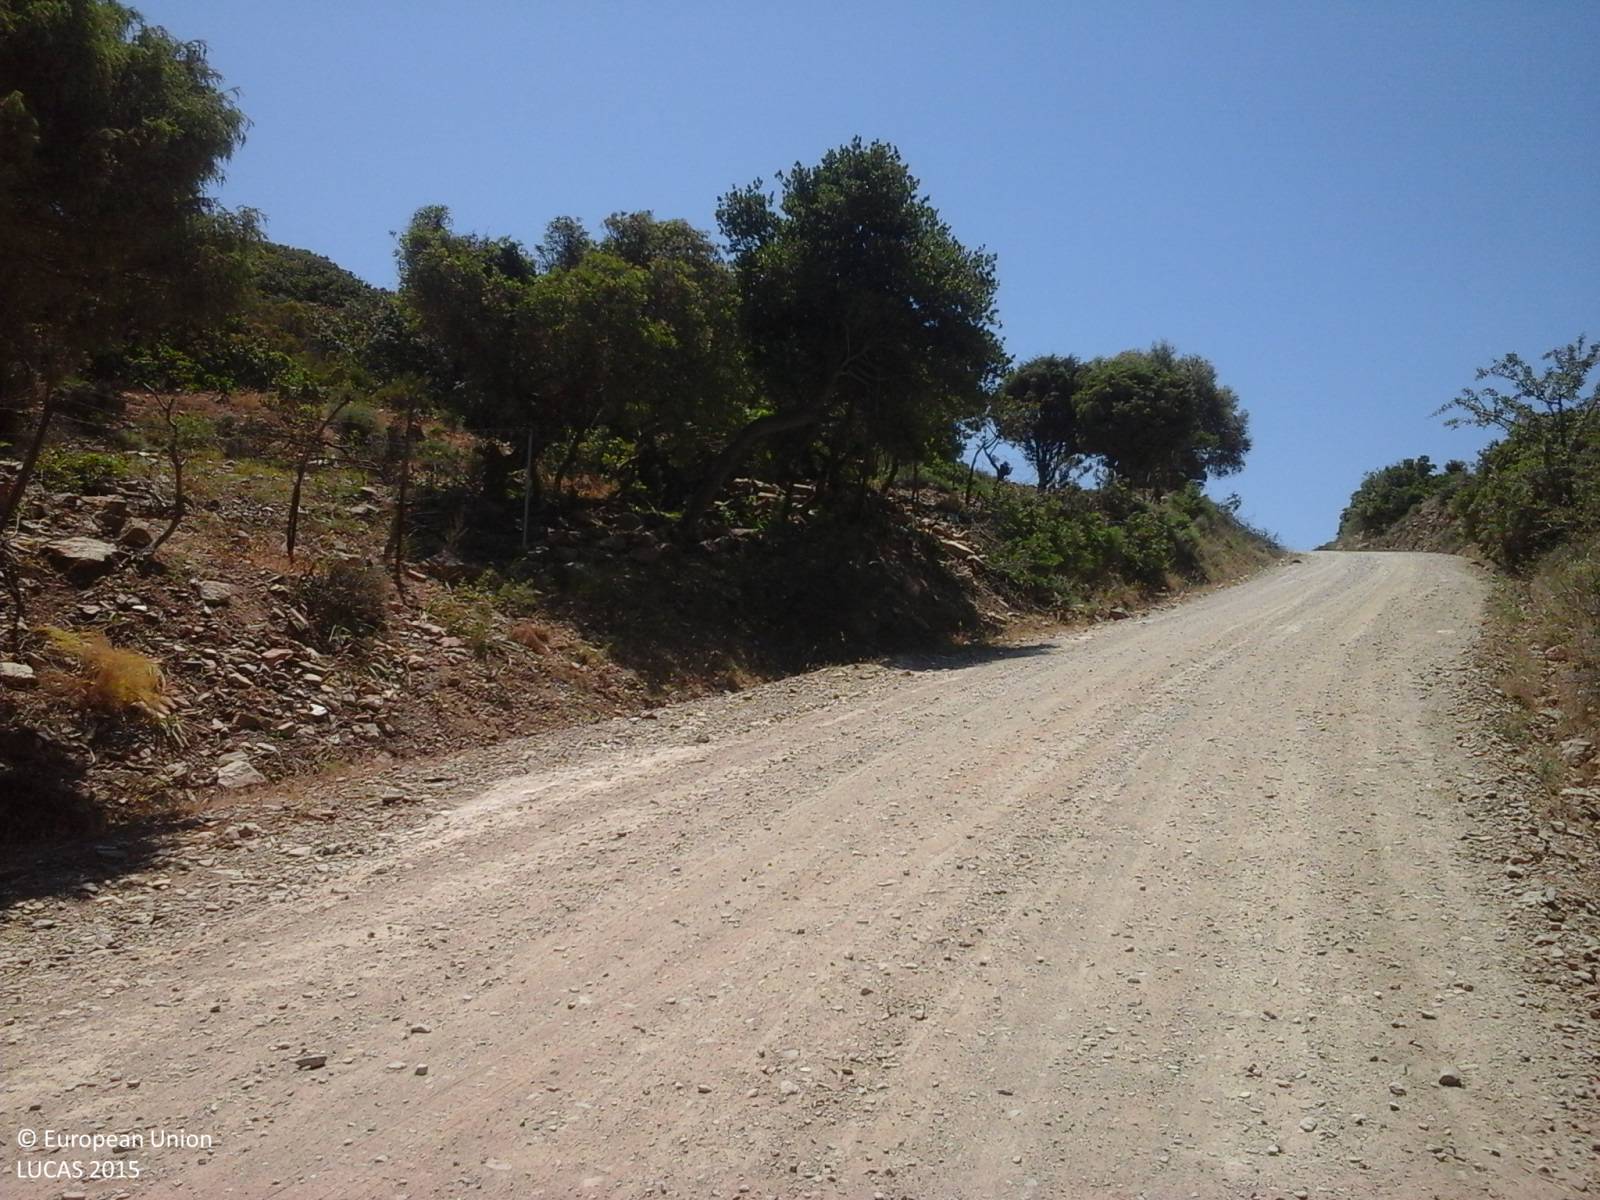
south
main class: Woodland
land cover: Broadleaved woodland
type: broadleaved evergreen forest
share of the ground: > 75 %
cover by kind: broadleaved forest trees 50 %, shrubs 30 %, coniferous forest trees 10 %, herbaceous plants 10 %
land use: Agriculture (excluding fallow land and kitchen gardens)
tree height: > 5 m
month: June
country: IT
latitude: 38.9552
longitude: 8.7732
